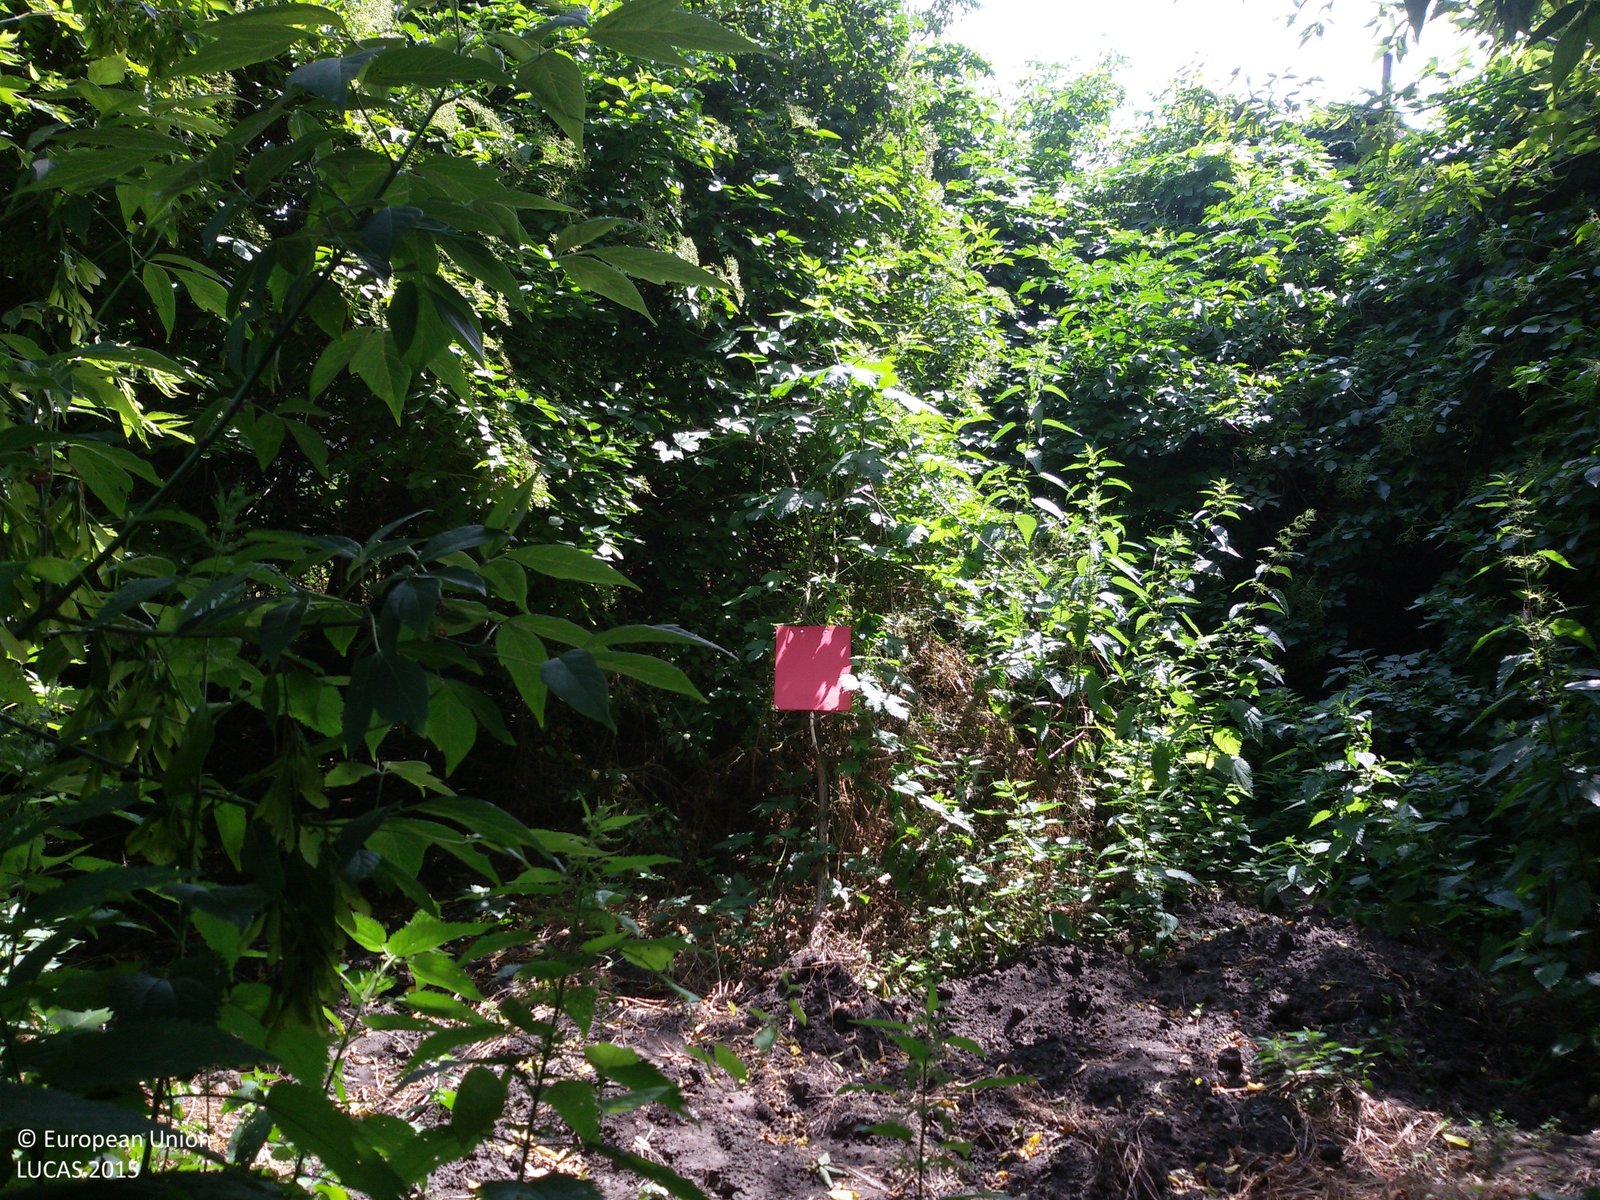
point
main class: Woodland
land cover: Broadleaved woodland
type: mesophytic deciduous forest
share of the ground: 25 - 50 %
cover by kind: herbaceous plants 60 %, broadleaved forest trees 25 %, shrubs 15 %
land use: Semi-natural and natural areas not in use
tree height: < 5 m
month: July
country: PL
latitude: 52.6439
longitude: 19.0833
